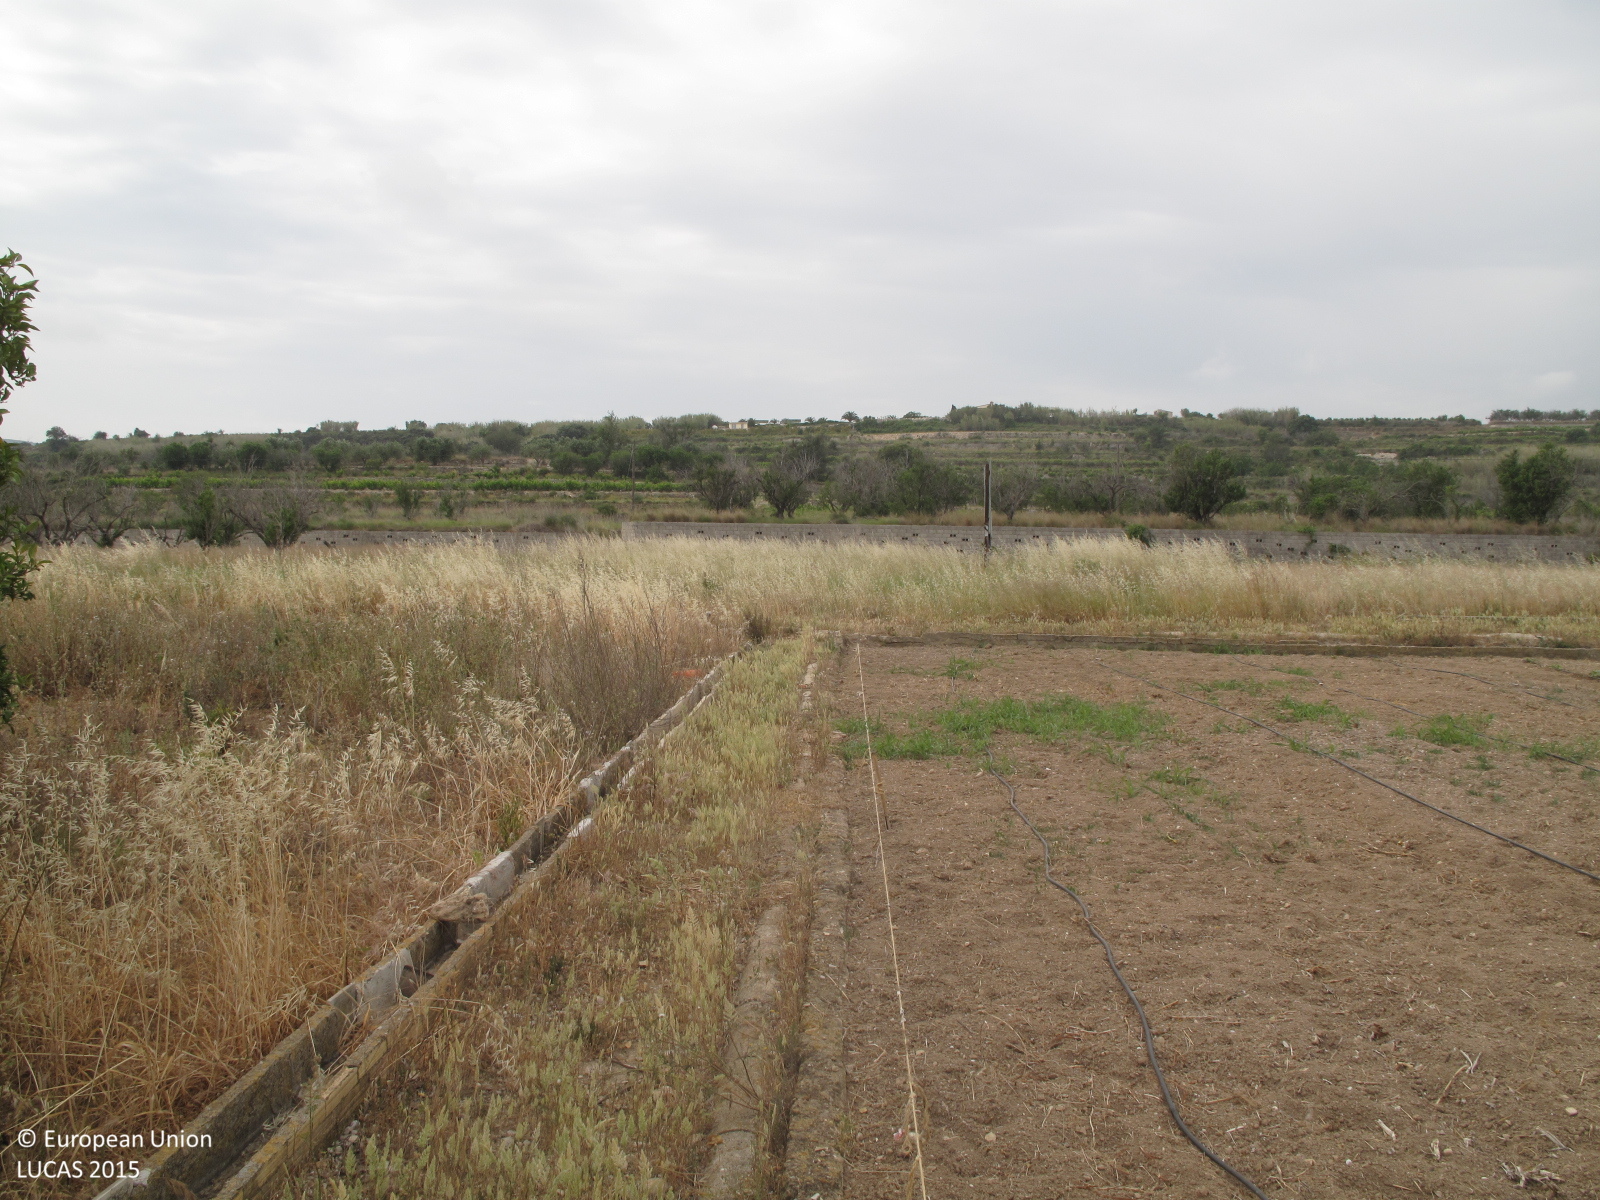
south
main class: Cropland
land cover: Oranges
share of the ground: < 10 %
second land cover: Other bare soil
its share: > 75 %
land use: Agriculture (excluding fallow land and kitchen gardens)
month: May
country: ES
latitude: 38.7811
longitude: 0.1005
